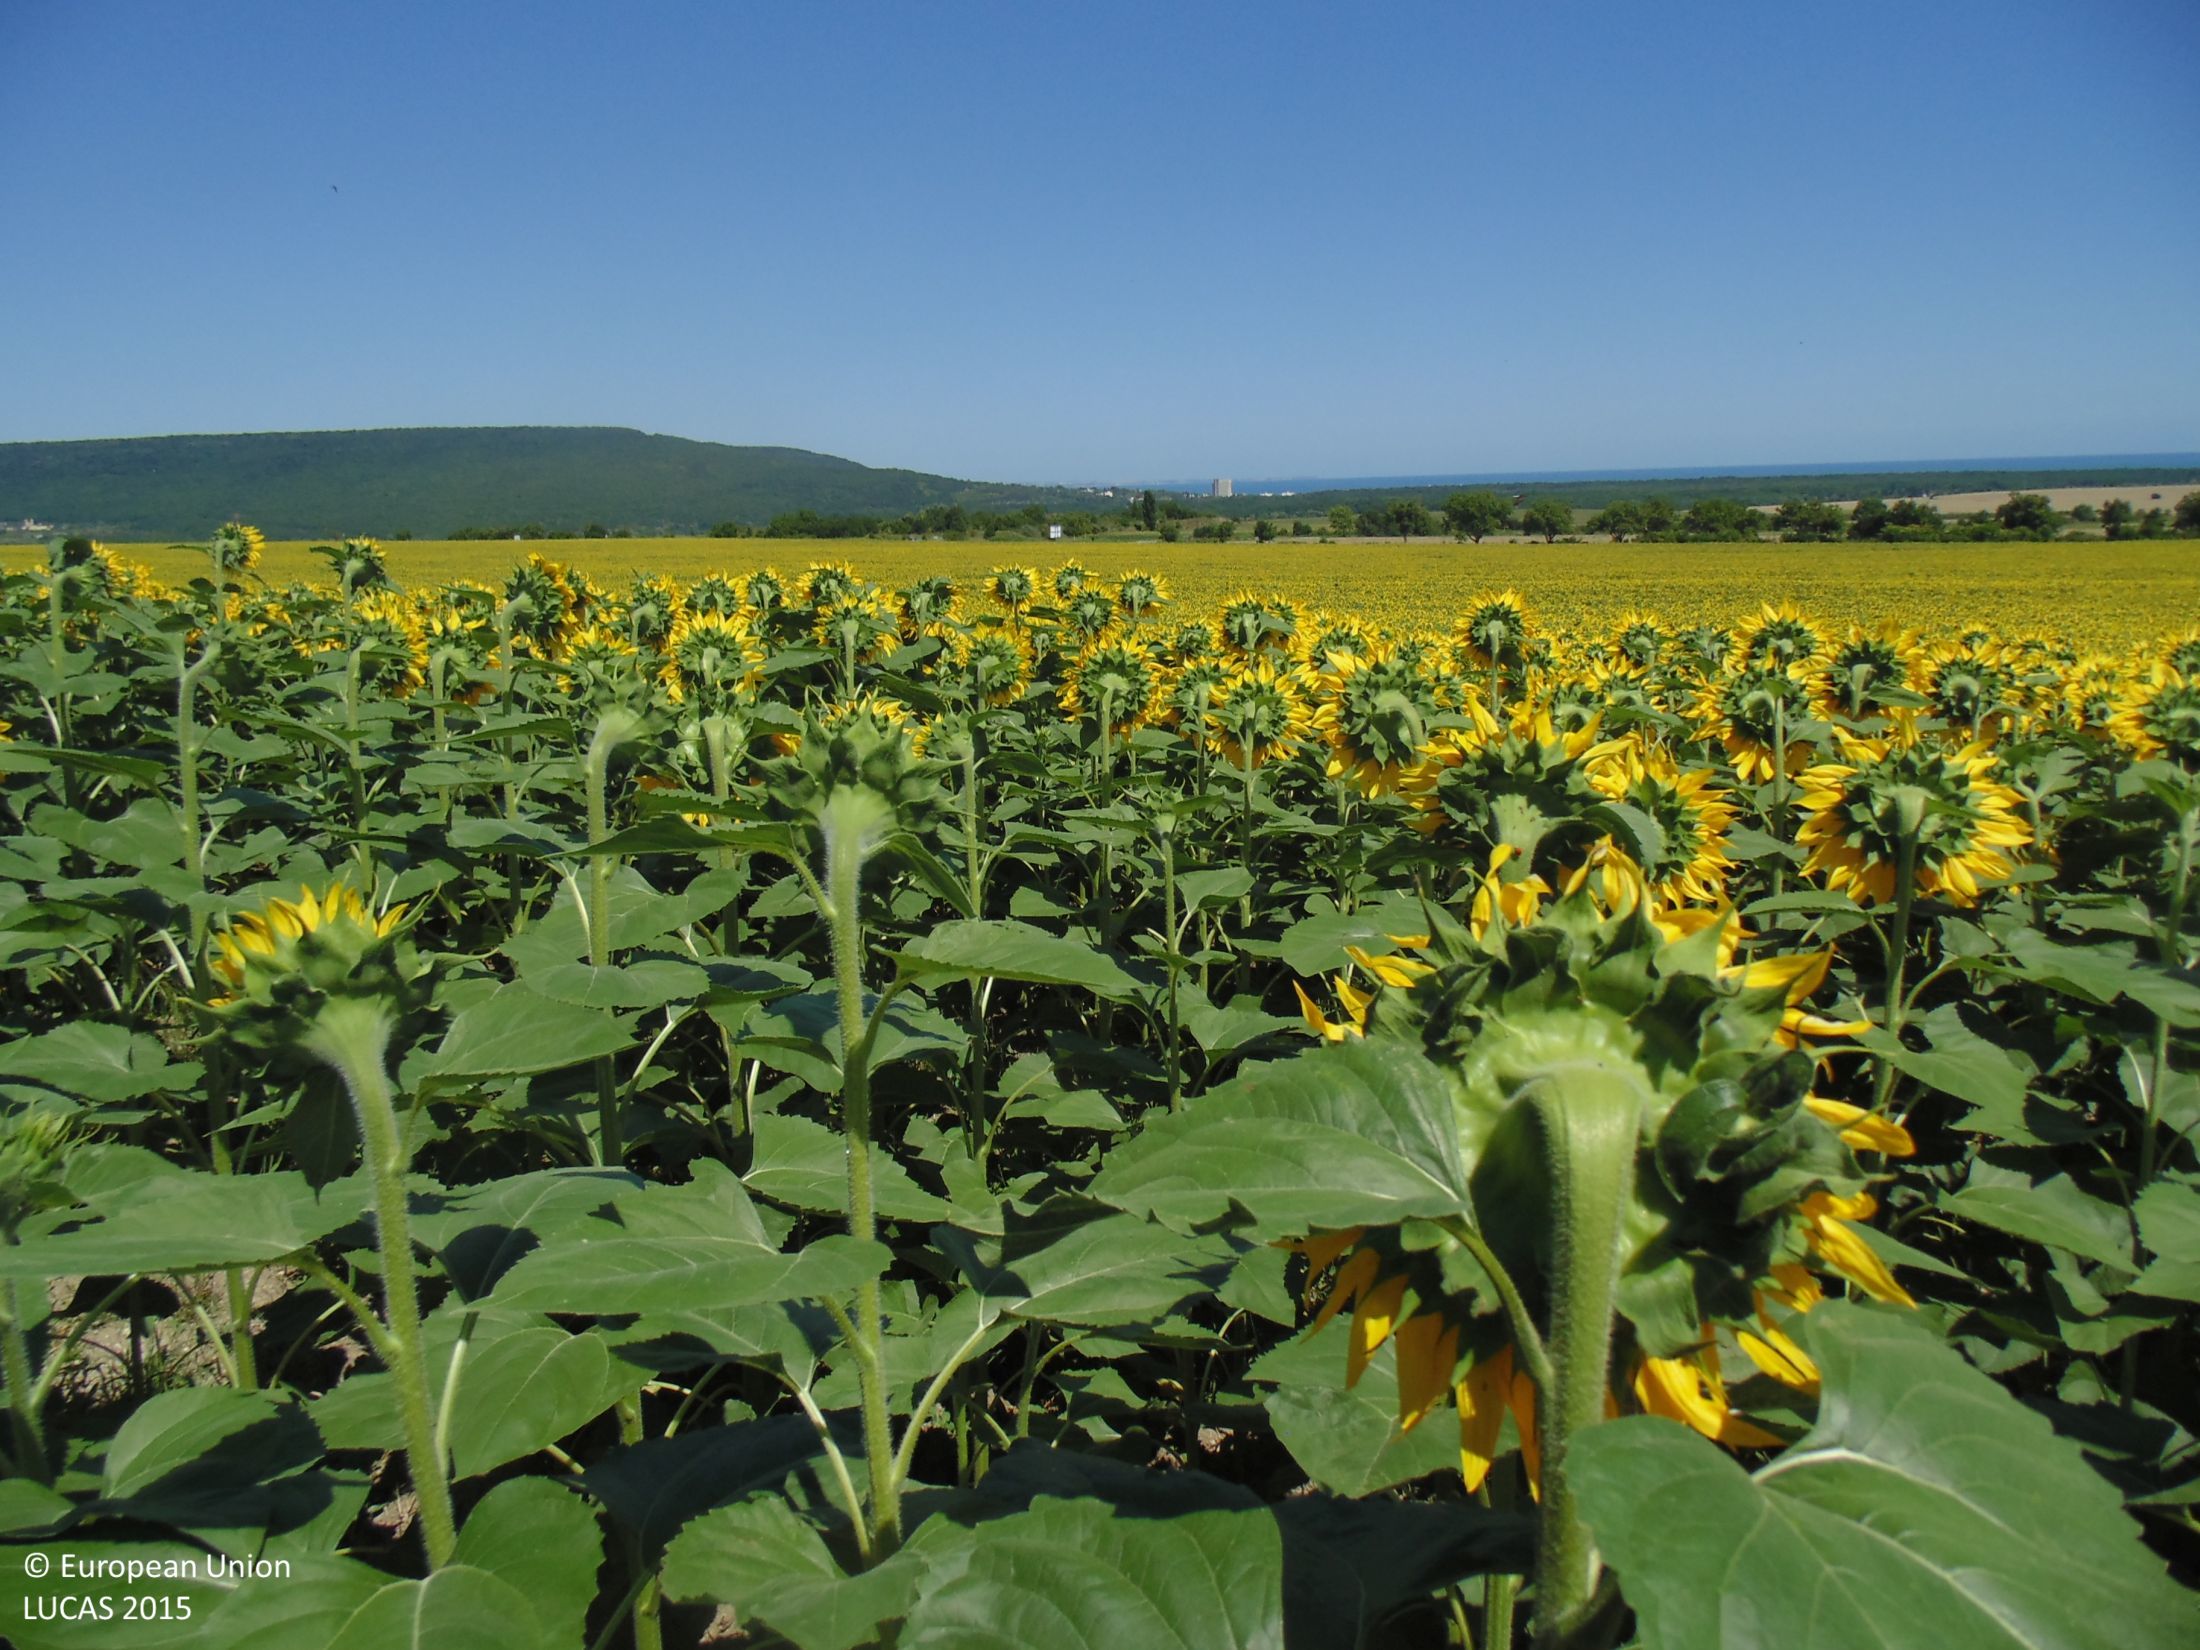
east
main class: Cropland
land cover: Sunflower
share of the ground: > 75 %
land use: Agriculture (excluding fallow land and kitchen gardens)
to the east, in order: Sunflower
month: July
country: BG
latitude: 43.3647
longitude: 28.0252
